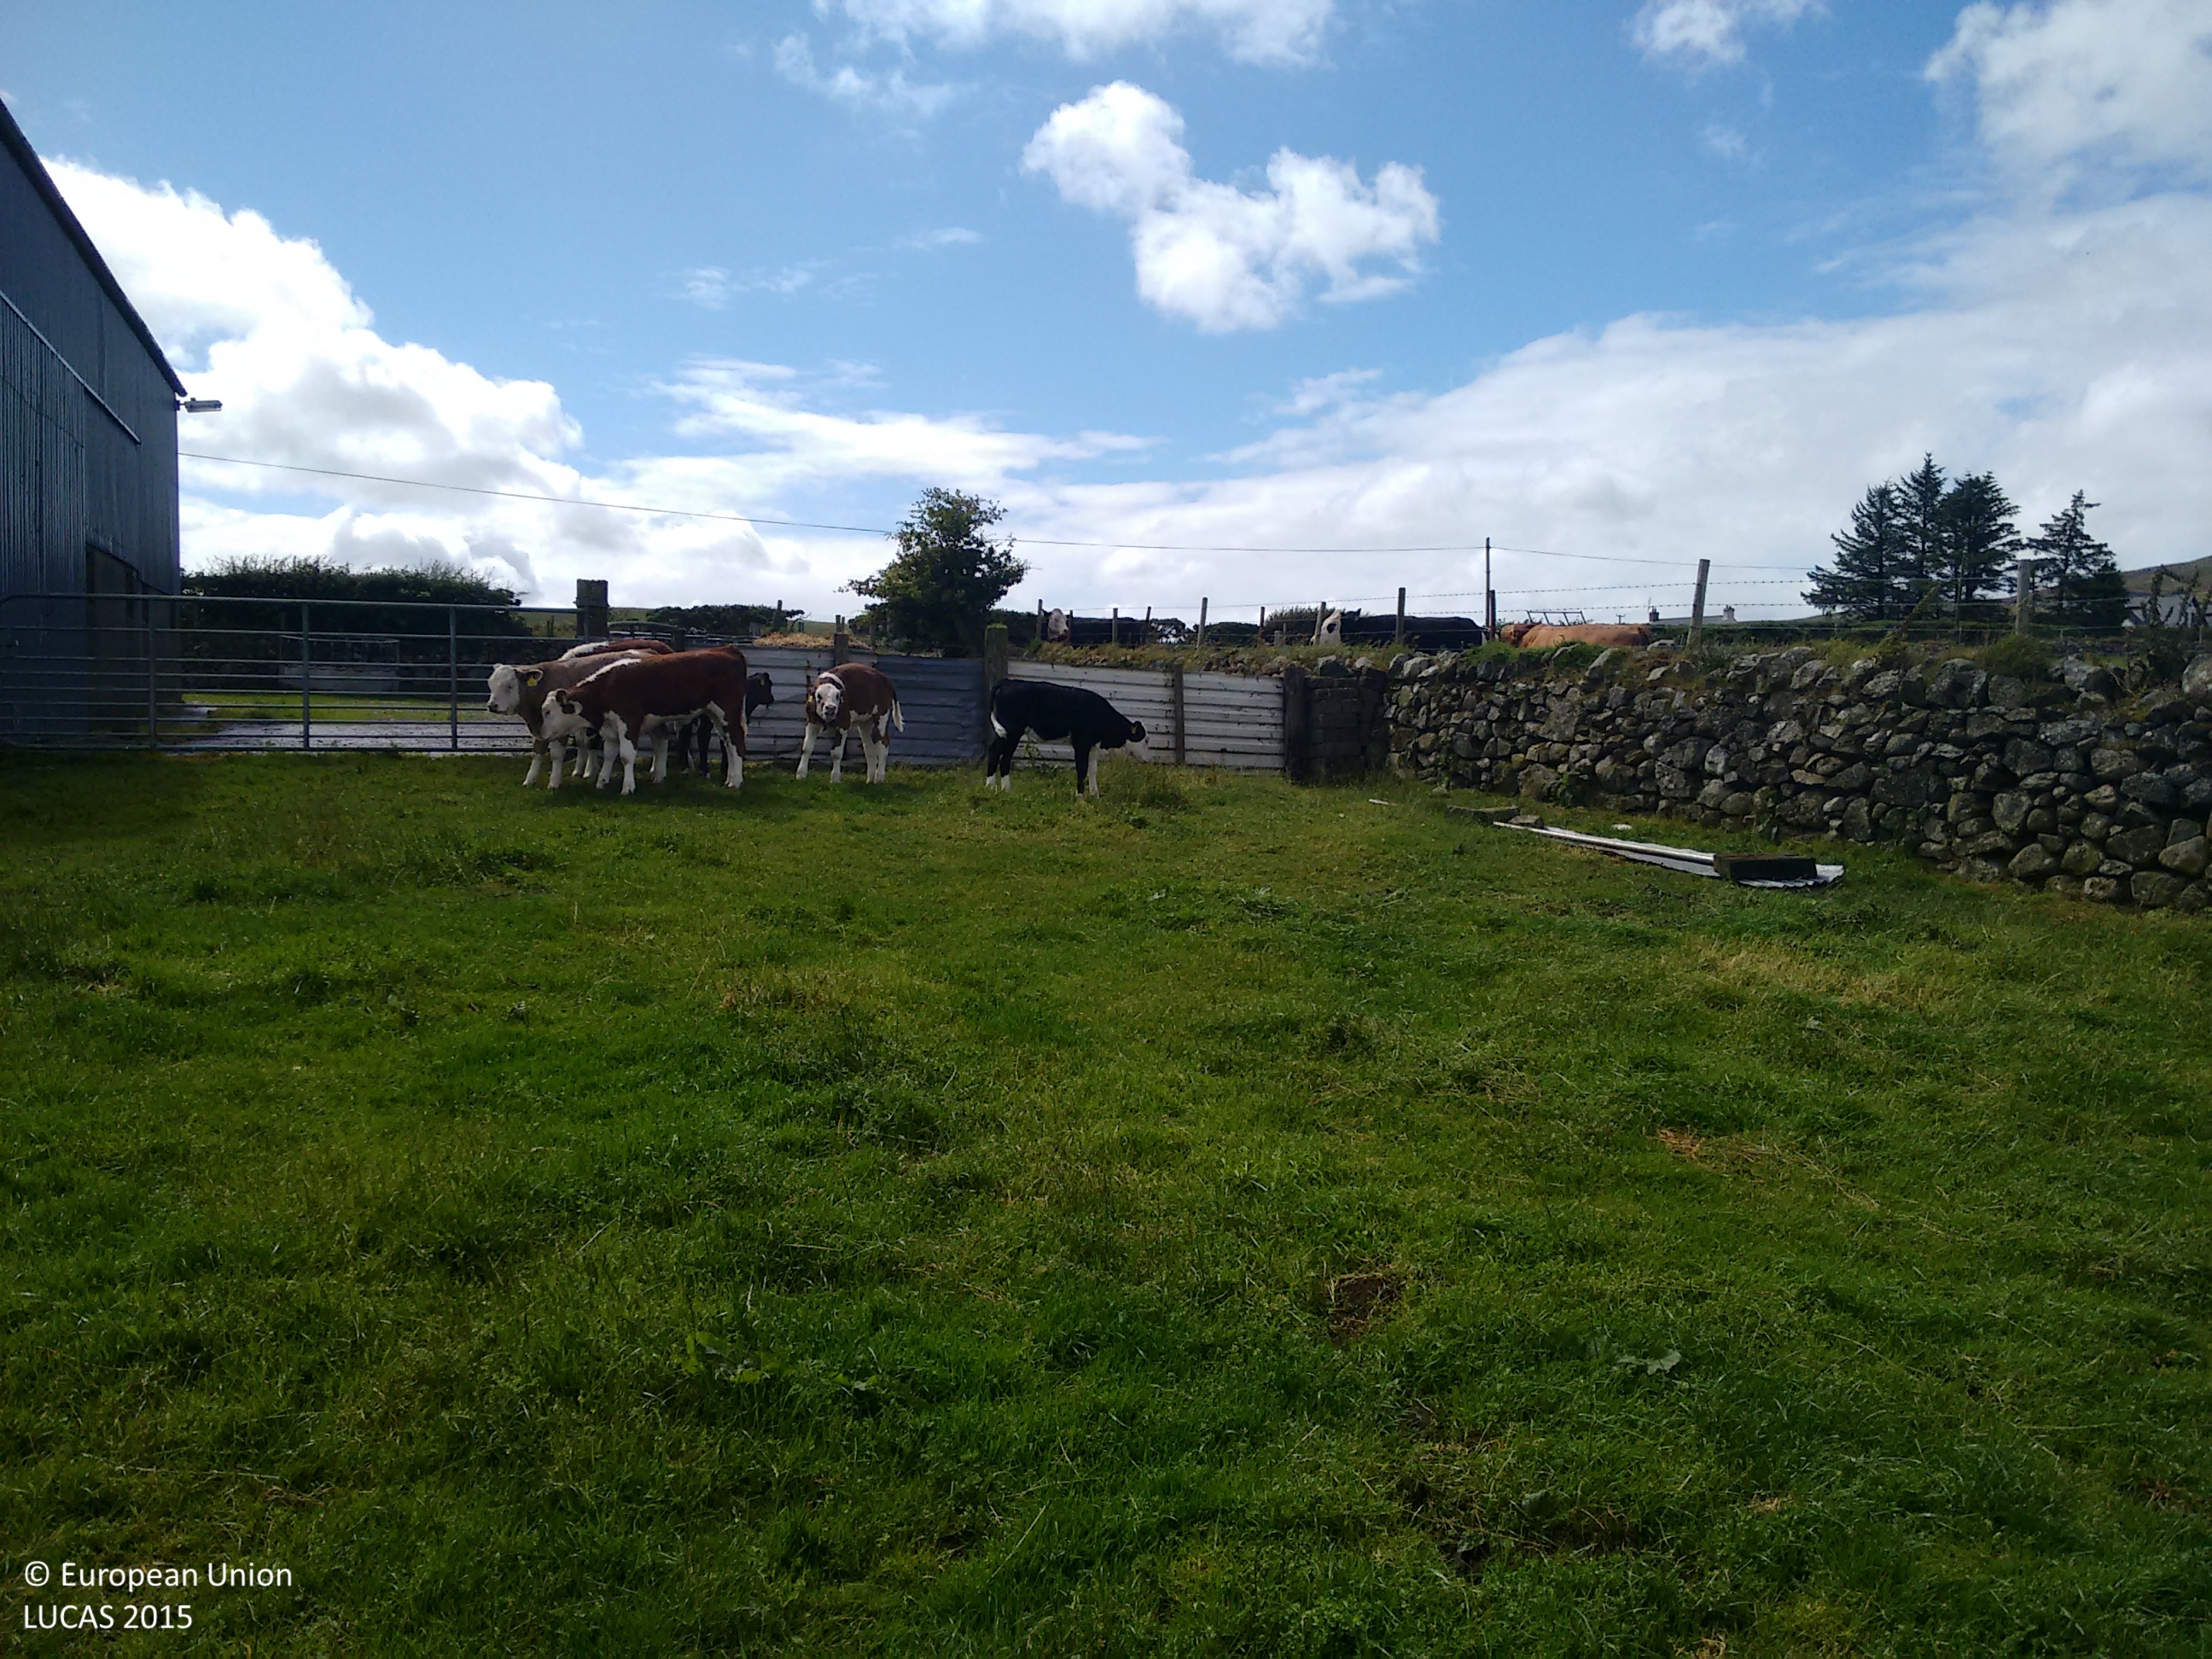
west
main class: Grassland
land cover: Grassland without tree/shrub cover
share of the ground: > 75 %
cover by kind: herbaceous plants 100 %
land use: Agriculture (excluding fallow land and kitchen gardens)
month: August
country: IE
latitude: 54.0374
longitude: -6.2582
